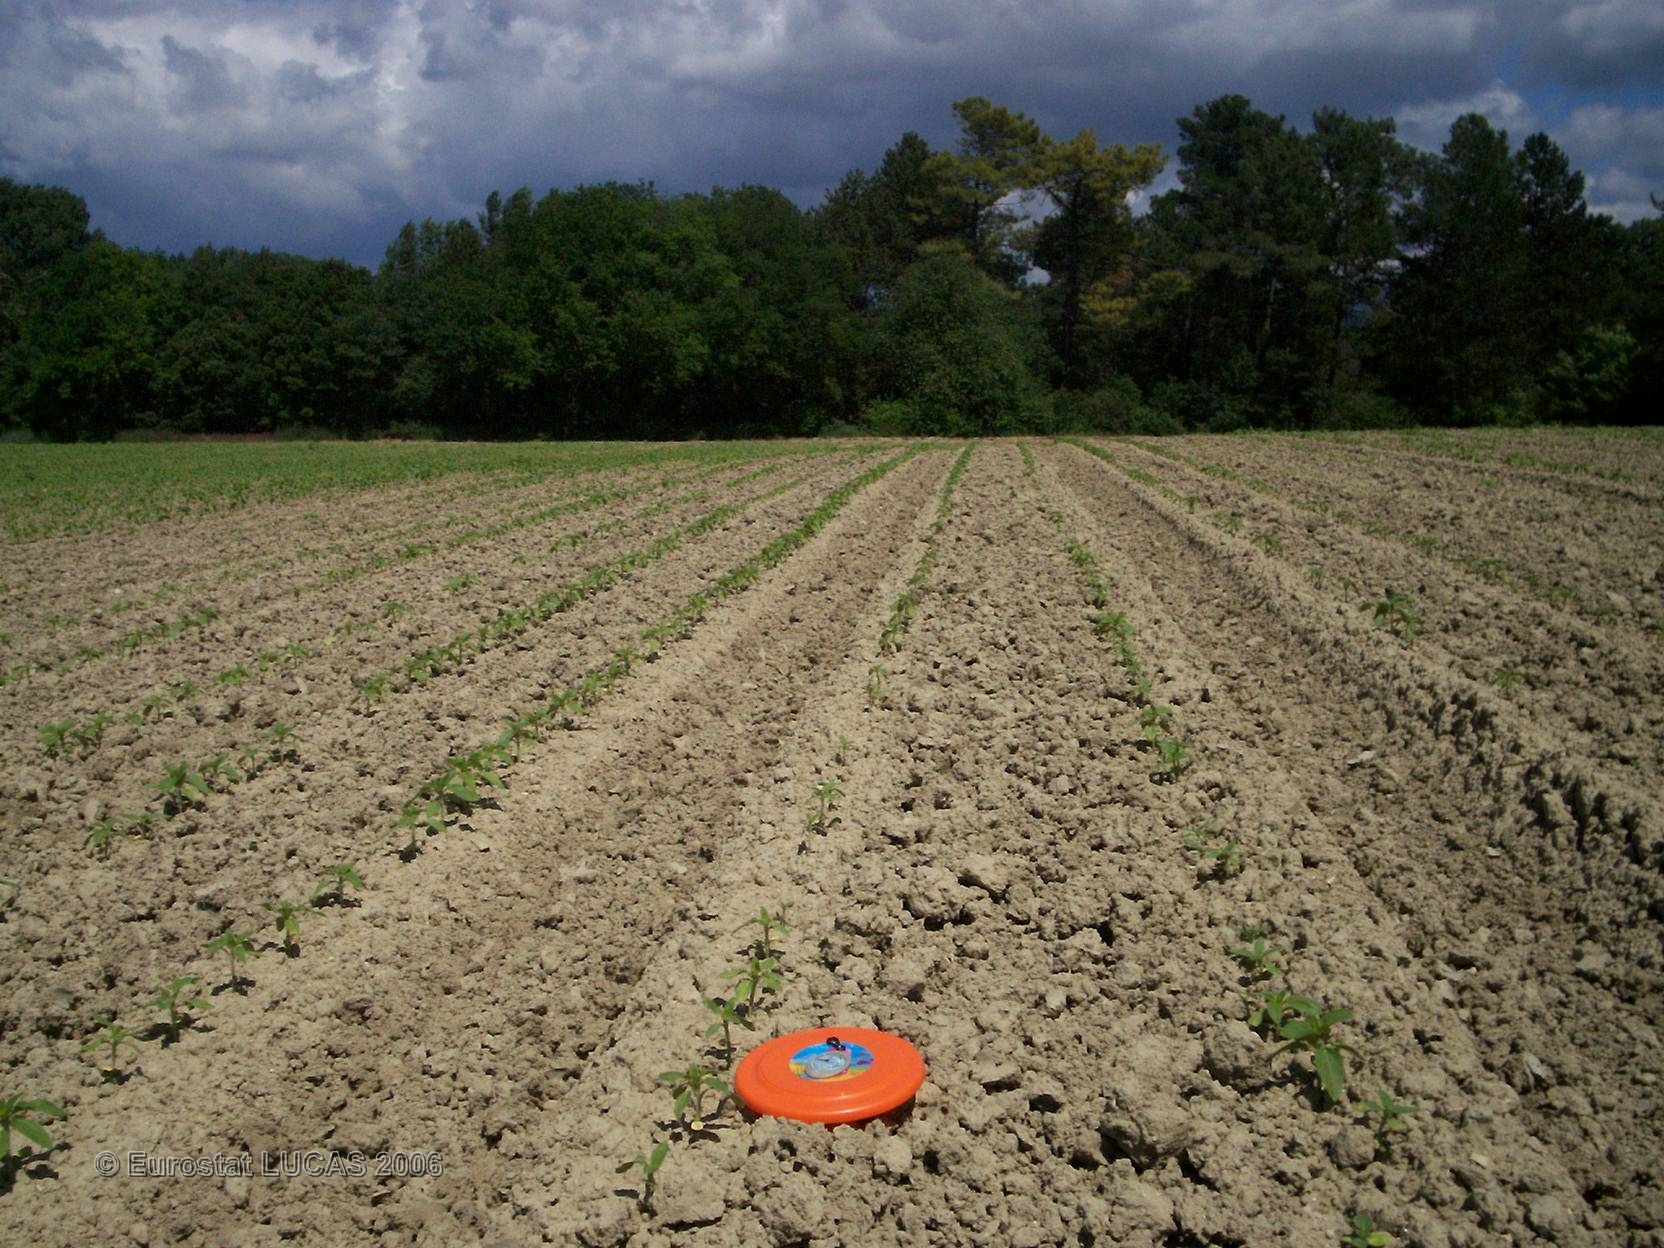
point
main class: Cropland
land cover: Sunflower
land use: Agriculture (excluding fallow land and kitchen gardens)
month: May
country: FR
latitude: 44.5483
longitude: 4.8585
